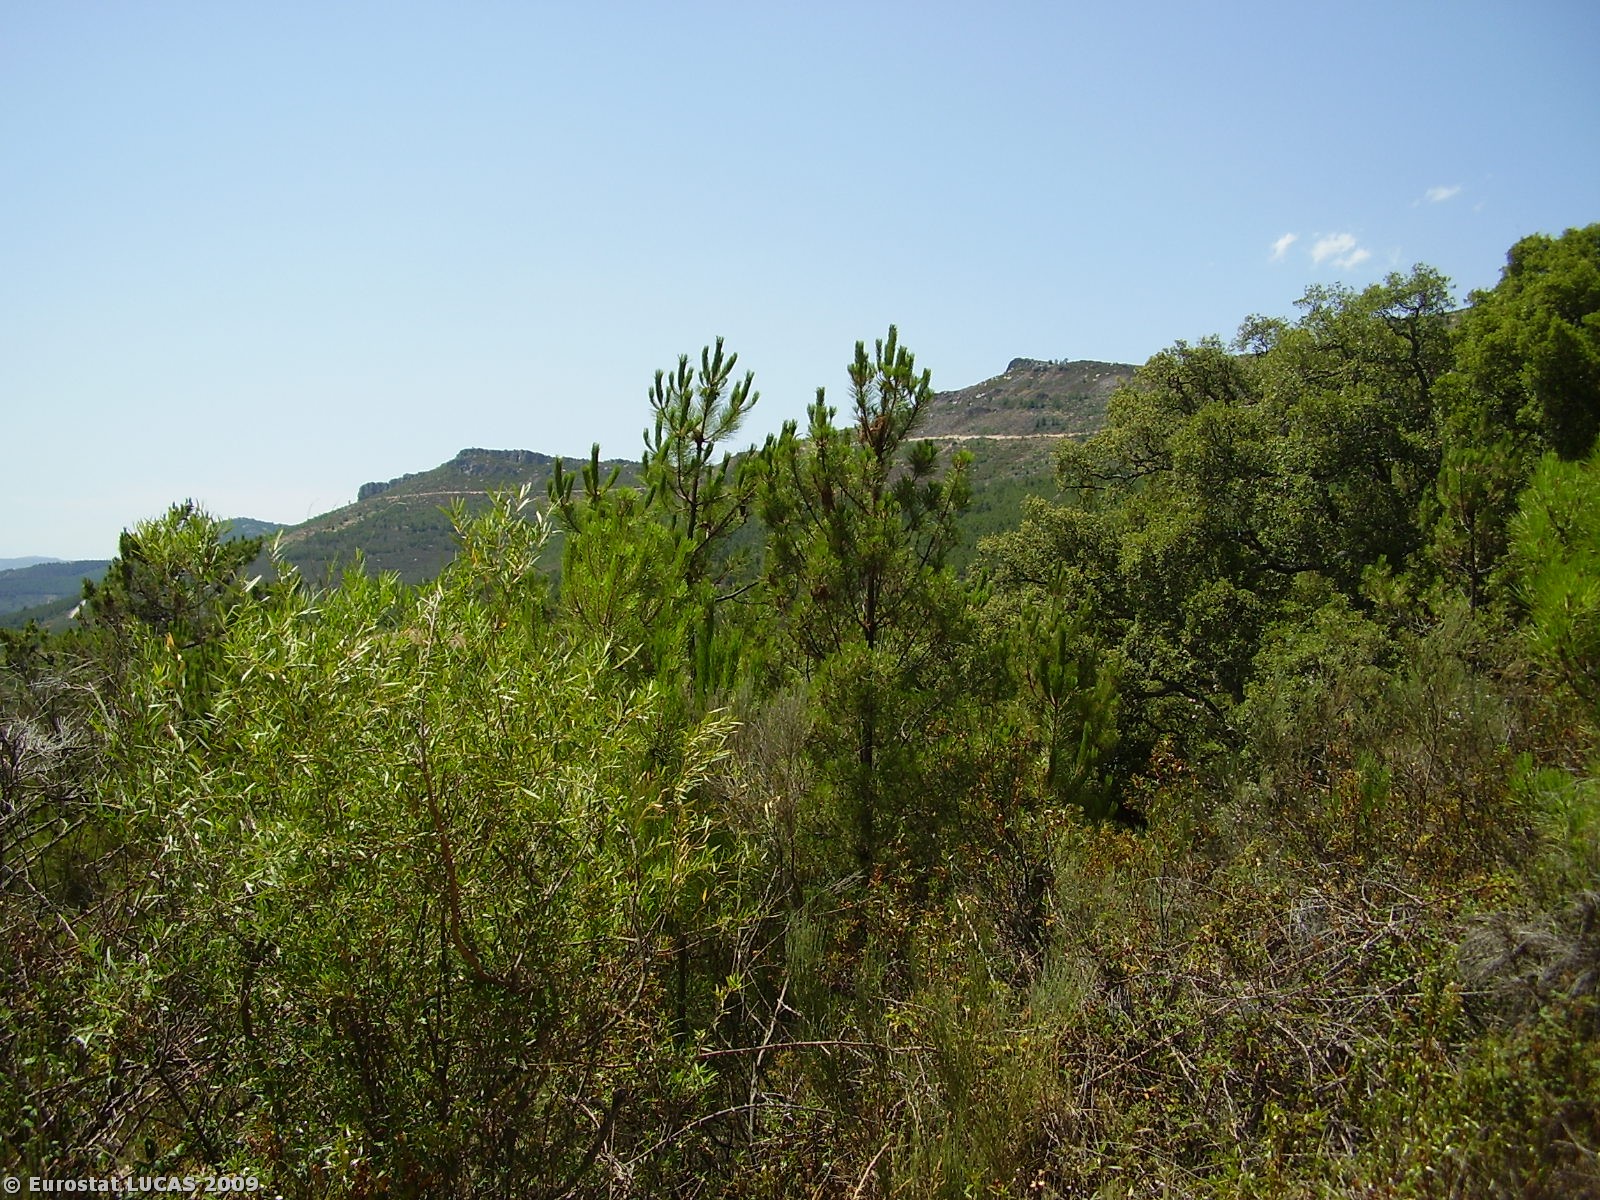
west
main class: Shrubland
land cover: Shrubland with sparse tree cover
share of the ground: 50 - 75 %
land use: Unused
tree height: > 5 m
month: July
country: PT
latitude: 41.4431
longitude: -7.3212
